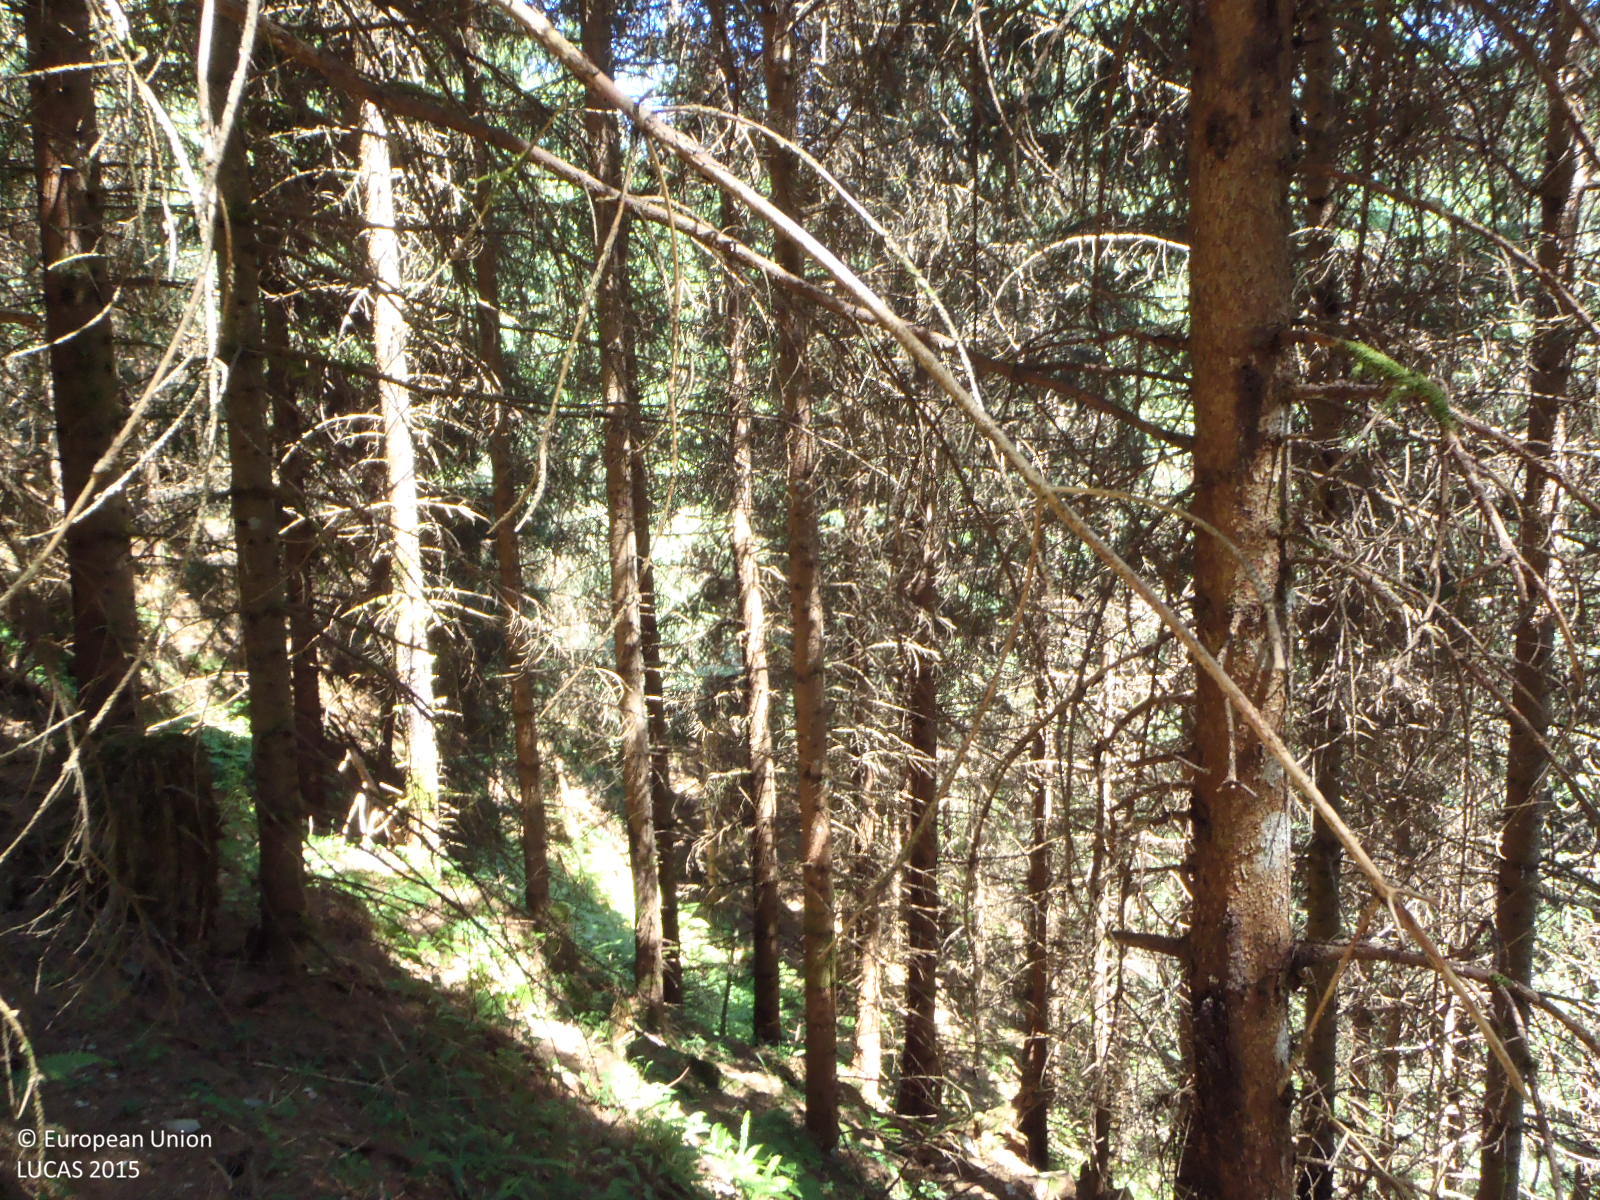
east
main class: Woodland
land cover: Spruce dominated coniferous woodland
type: alpine coniferous forest
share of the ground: > 75 %
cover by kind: coniferous forest trees 95 %, lichens and mosses 5 %
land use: Forestry
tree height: > 5 m
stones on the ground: < 10 %
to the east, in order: Spruce dominated coniferous woodland
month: July
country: AT
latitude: 47.3873
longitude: 12.3959
